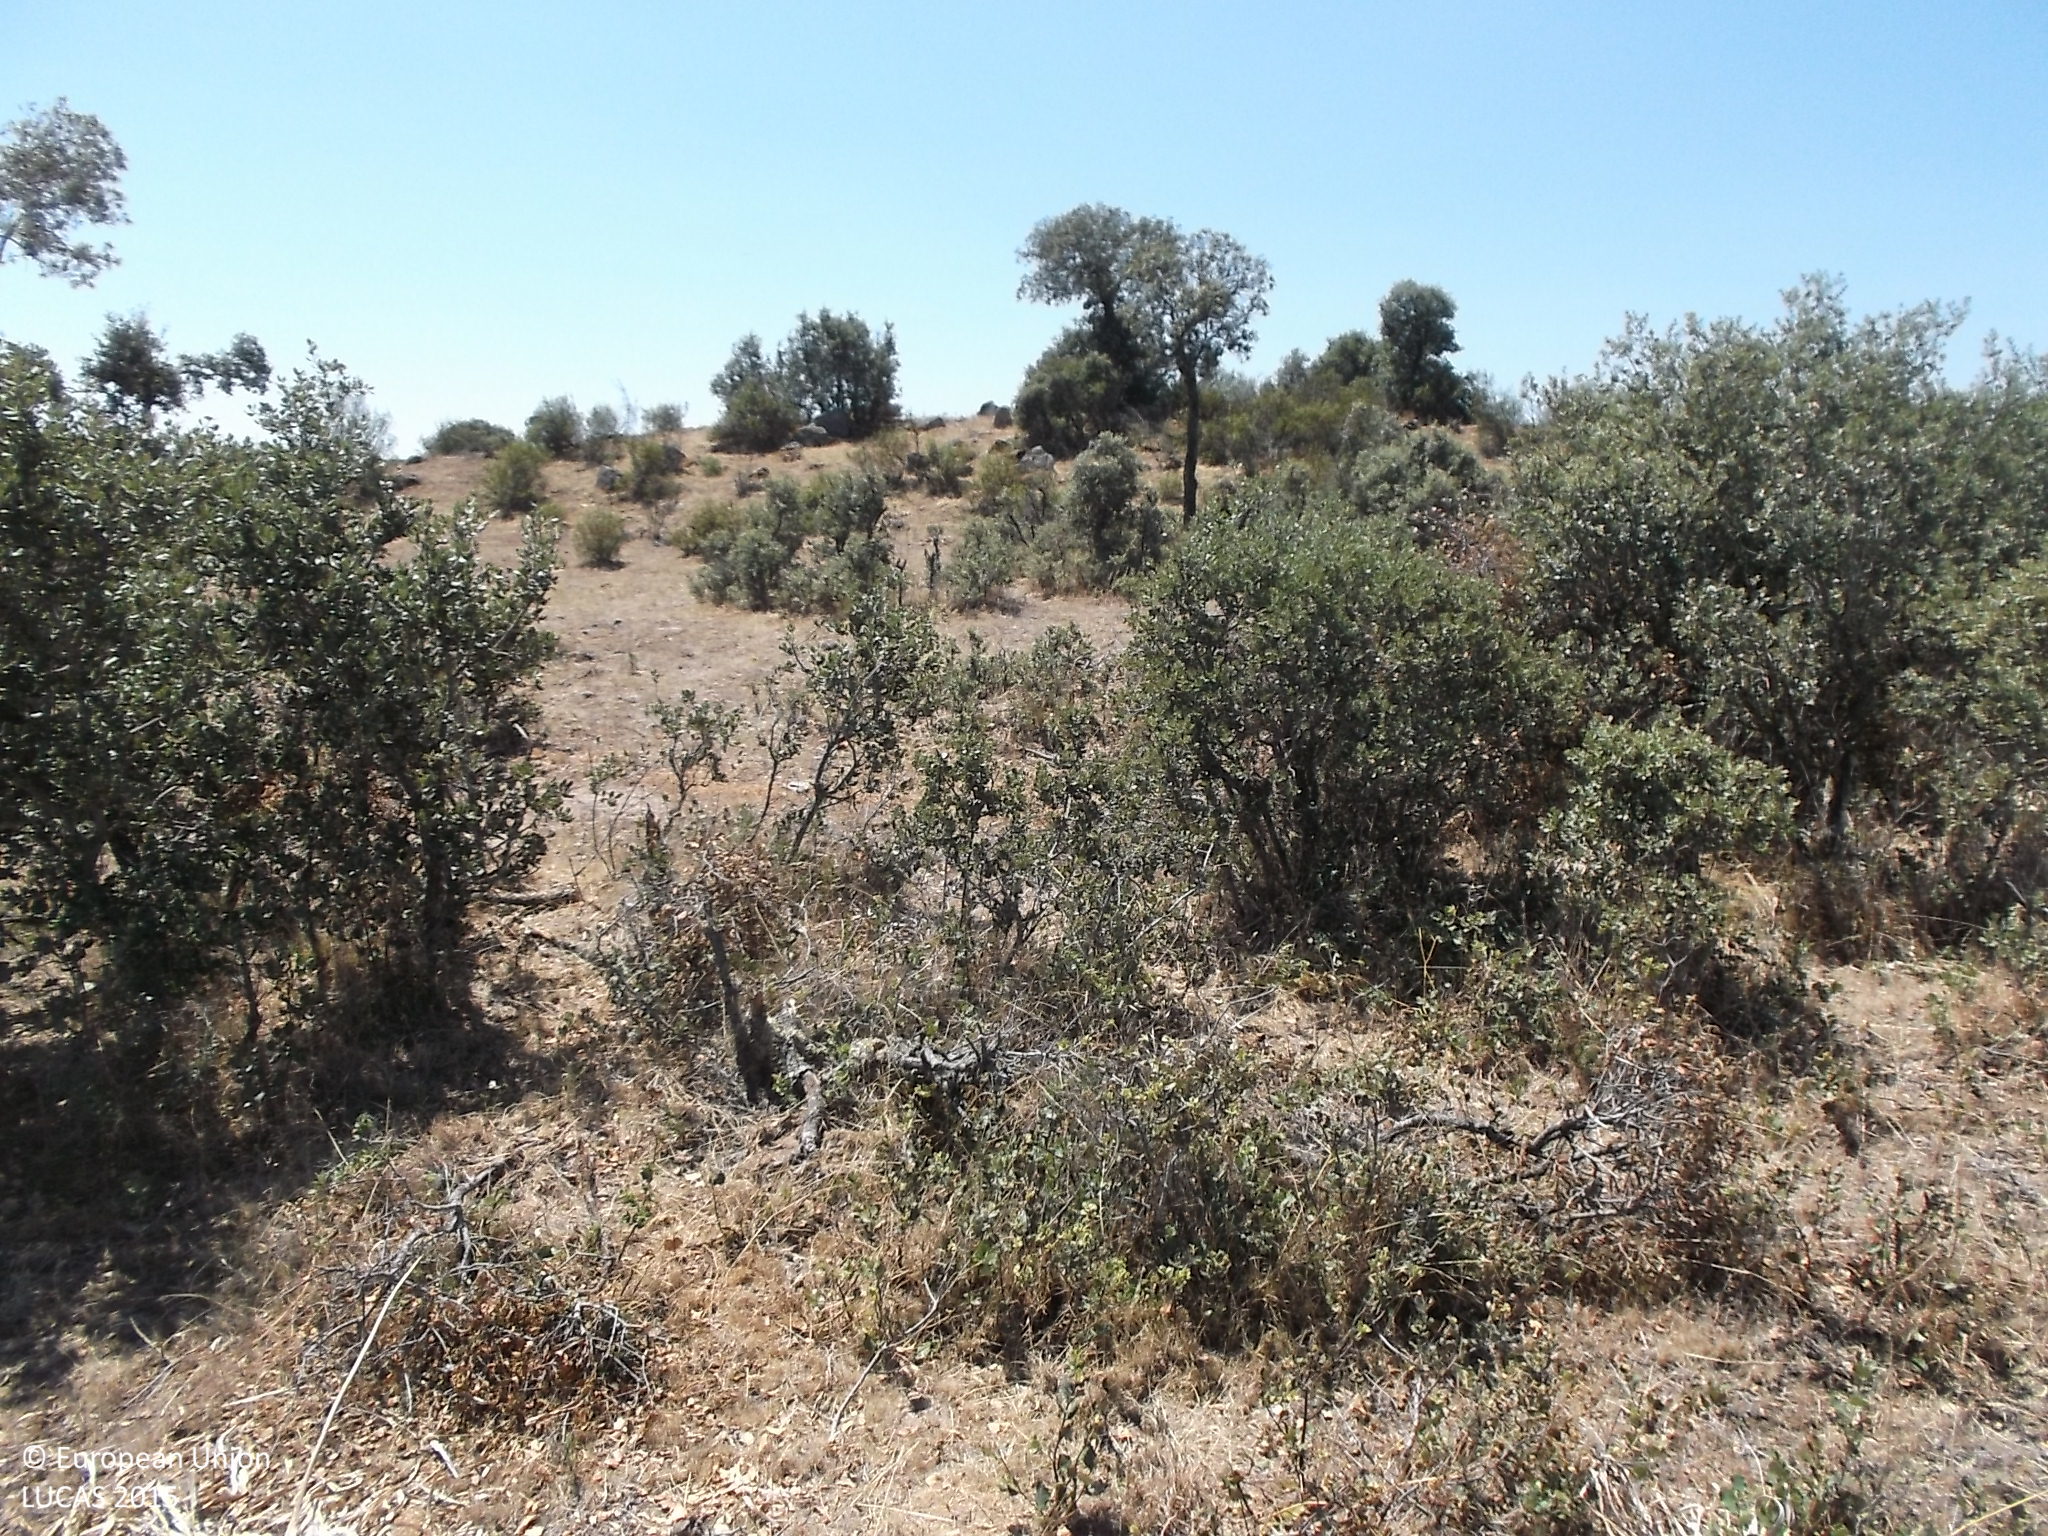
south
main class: Woodland
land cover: Broadleaved woodland
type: broadleaved evergreen forest
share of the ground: 10 - 25 %
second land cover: Grassland without tree/shrub cover
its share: > 75 %
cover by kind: herbaceous plants 80 %, broadleaved forest trees 20 %
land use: Forestry
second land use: Agriculture (excluding fallow land and kitchen gardens)
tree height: < 5 m
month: July
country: ES
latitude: 41.3456
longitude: -5.8255
